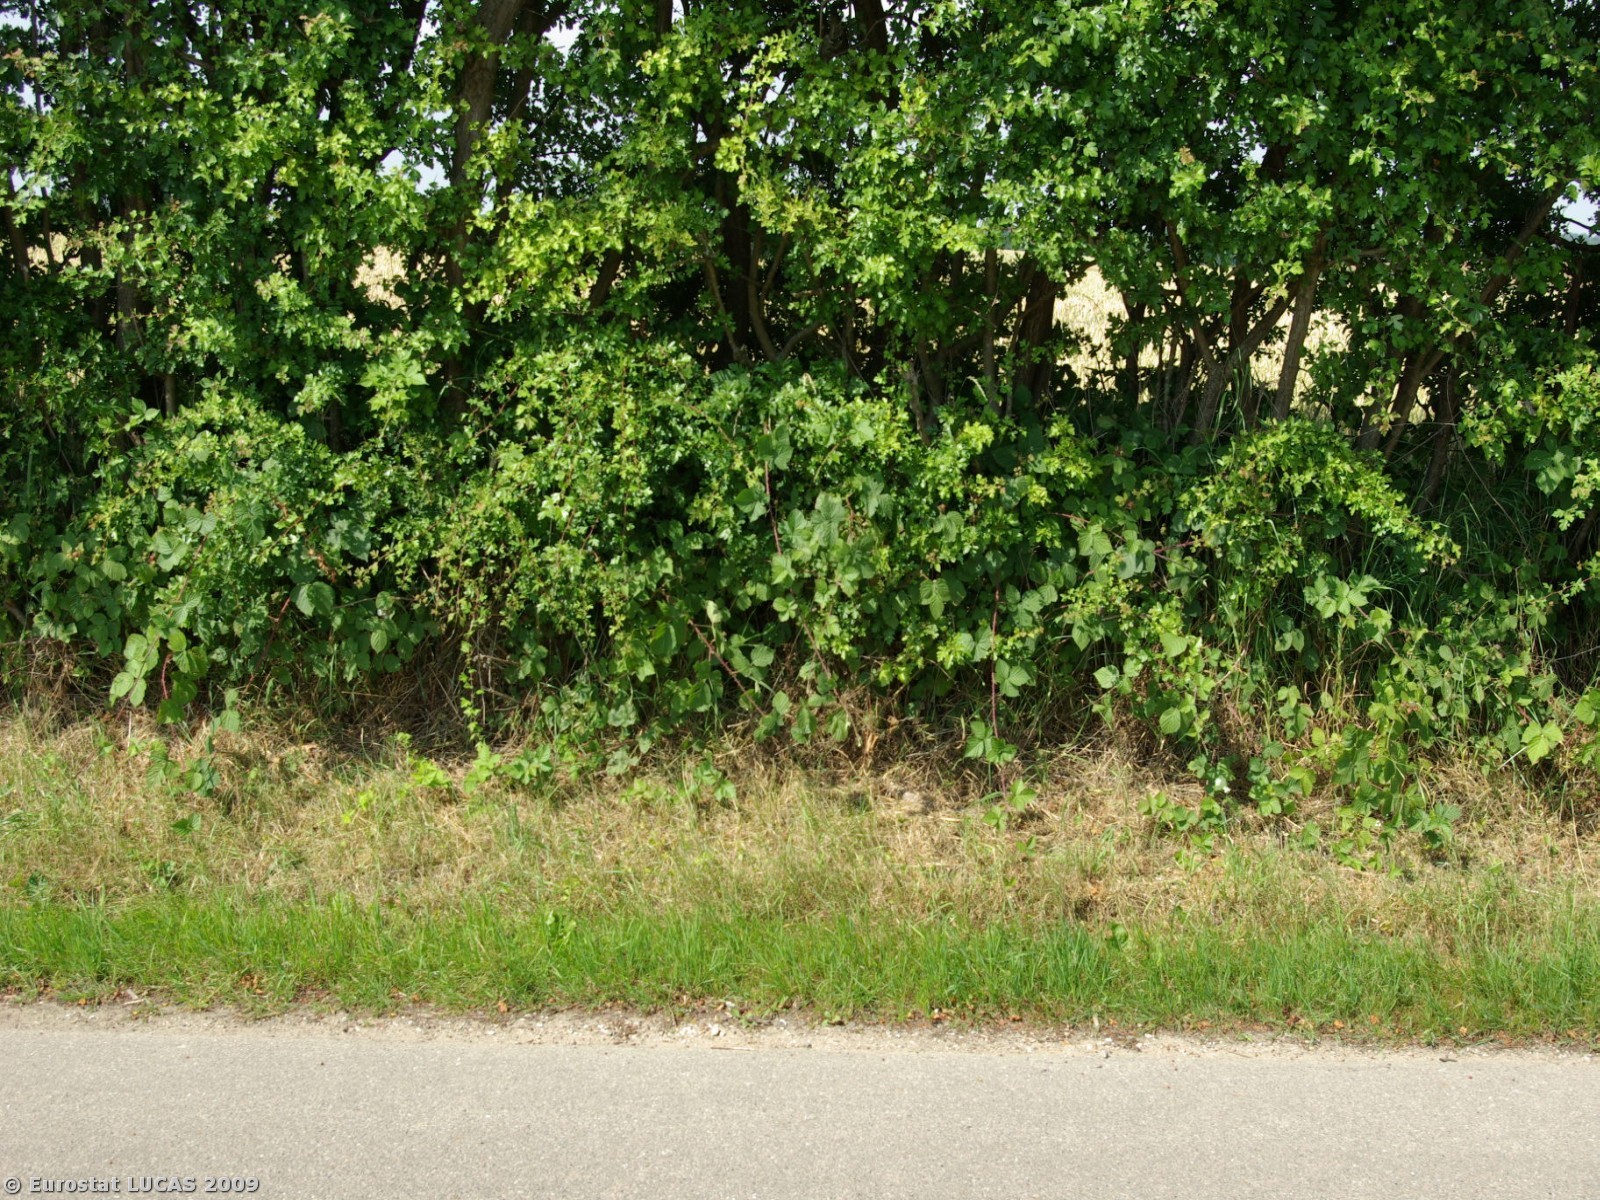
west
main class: Cropland
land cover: Common wheat
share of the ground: > 75 %
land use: Agriculture (excluding fallow land and kitchen gardens)
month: July
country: DK
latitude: 54.9652
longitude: 9.7347
